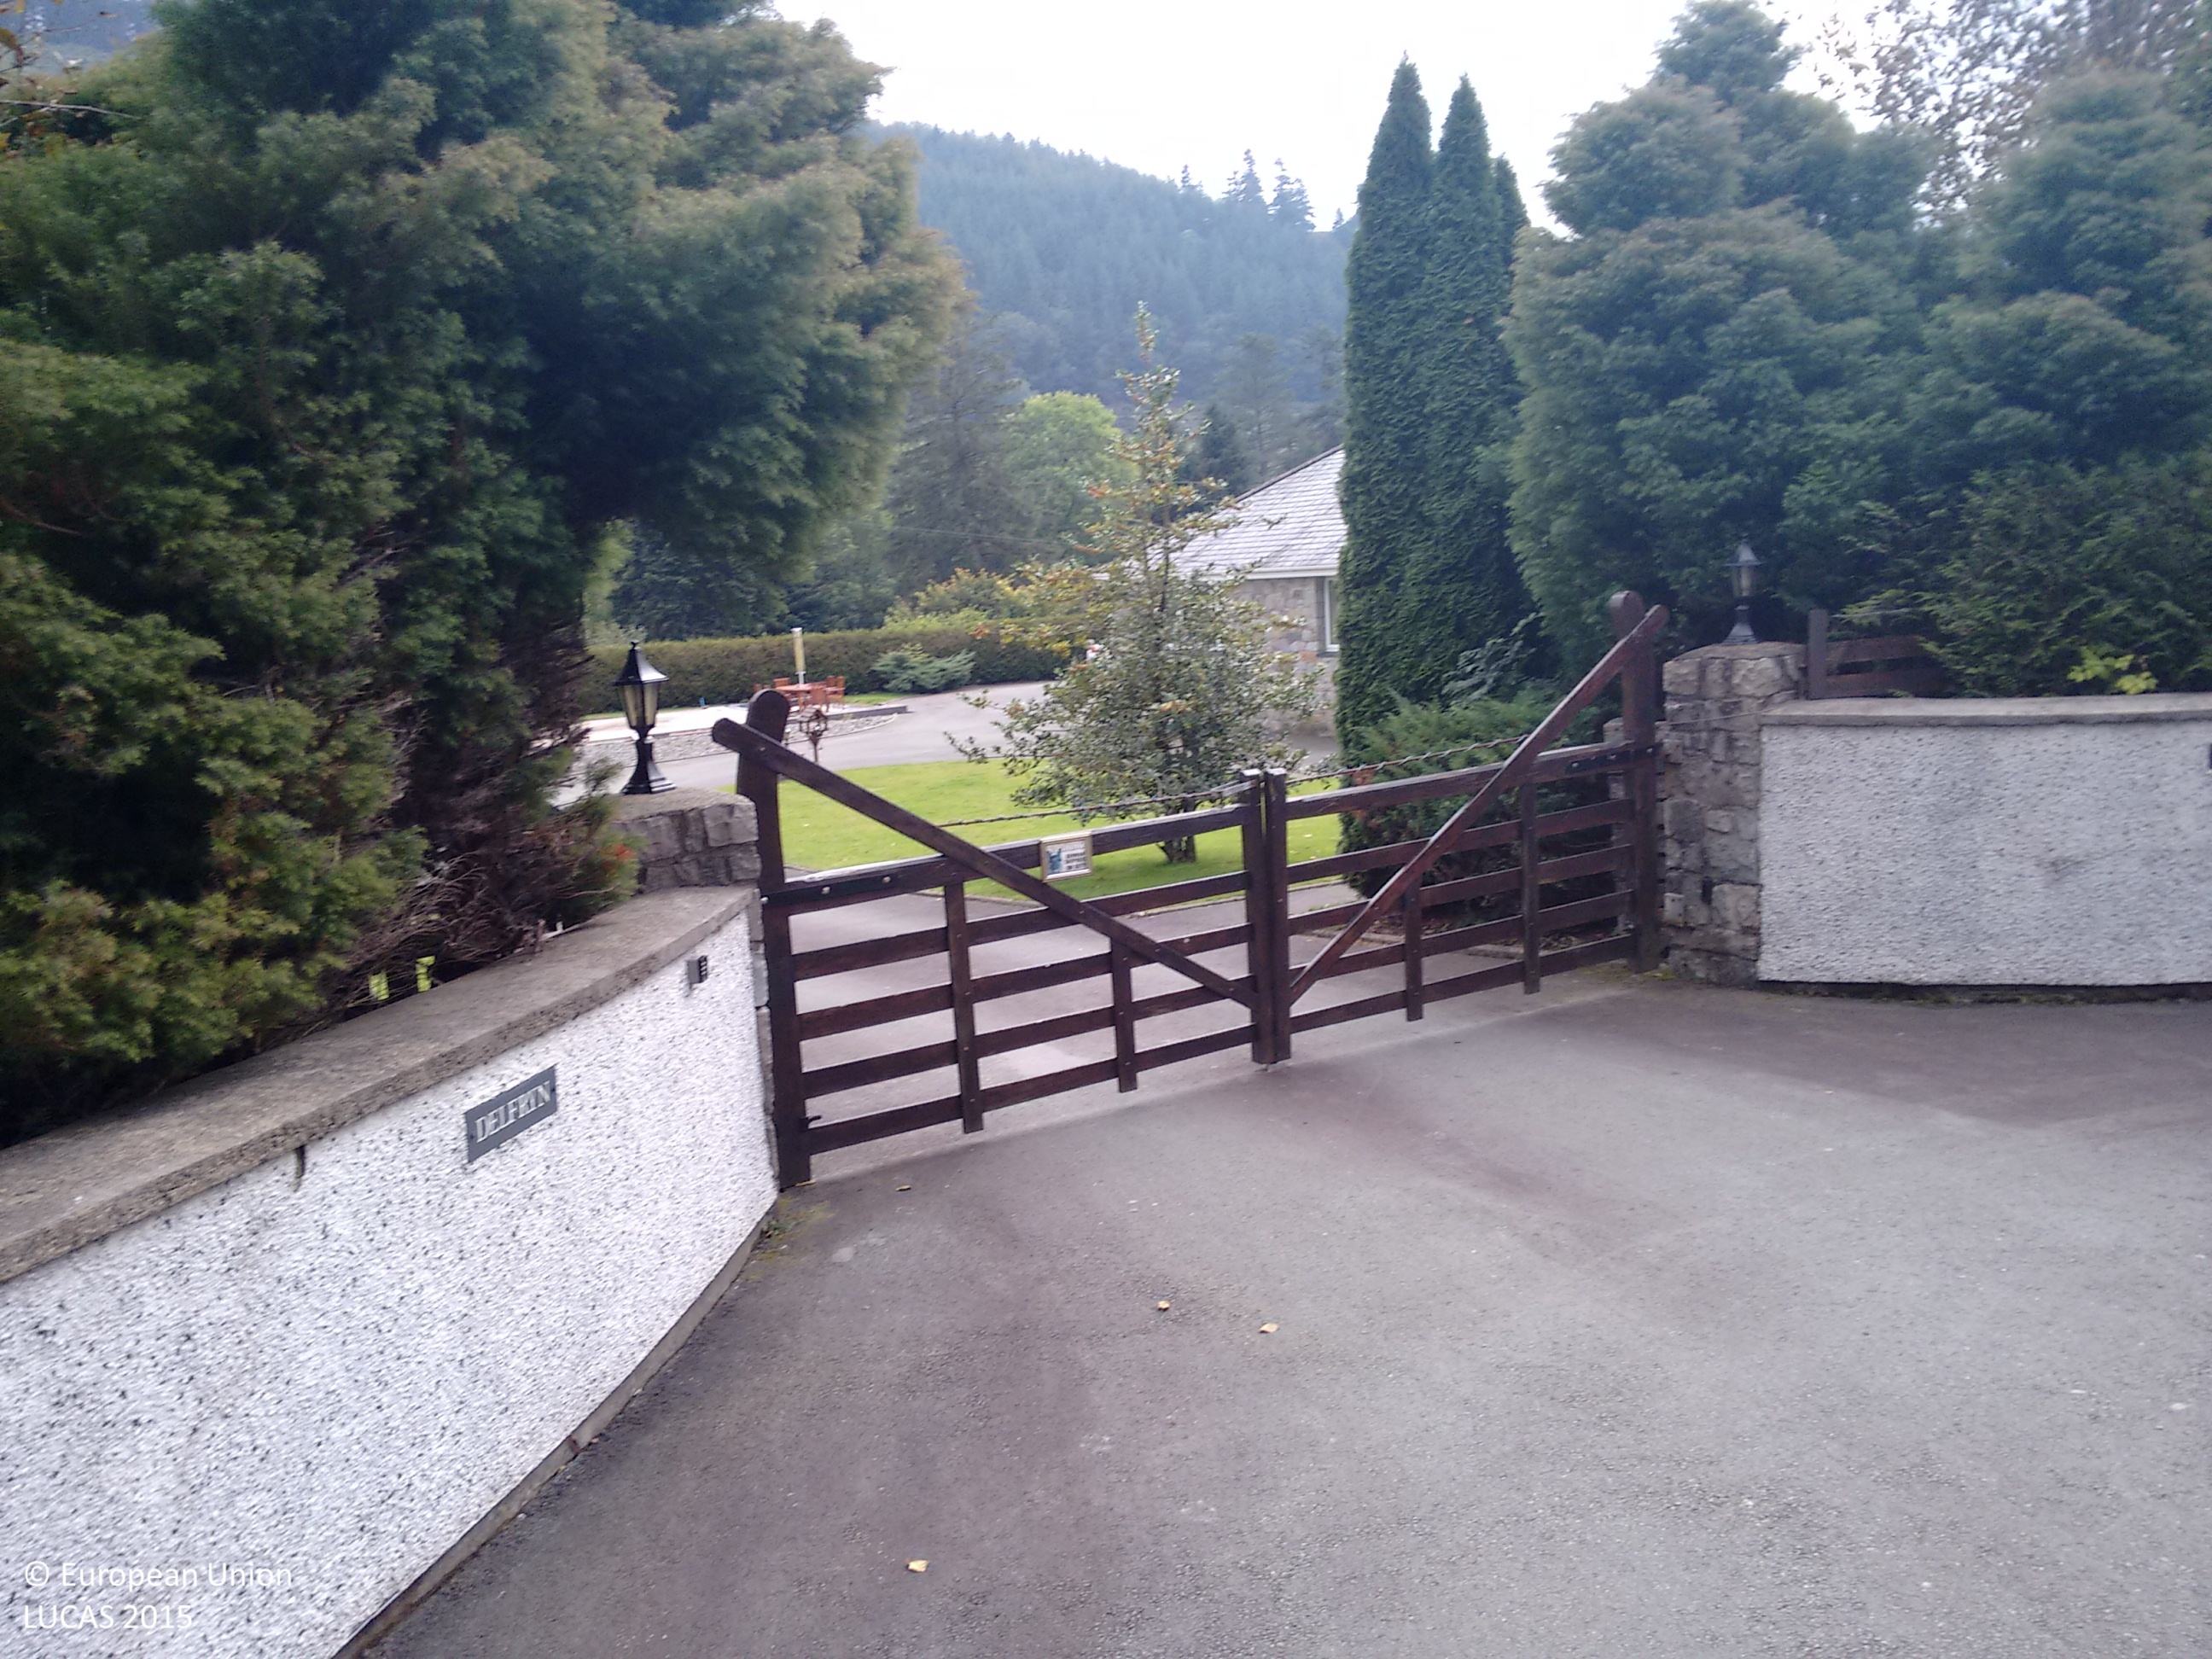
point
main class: Grassland
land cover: Grassland without tree/shrub cover
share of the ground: > 75 %
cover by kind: herbaceous plants 100 %
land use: Residential
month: September
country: GB
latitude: 52.7106
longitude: -3.6908
